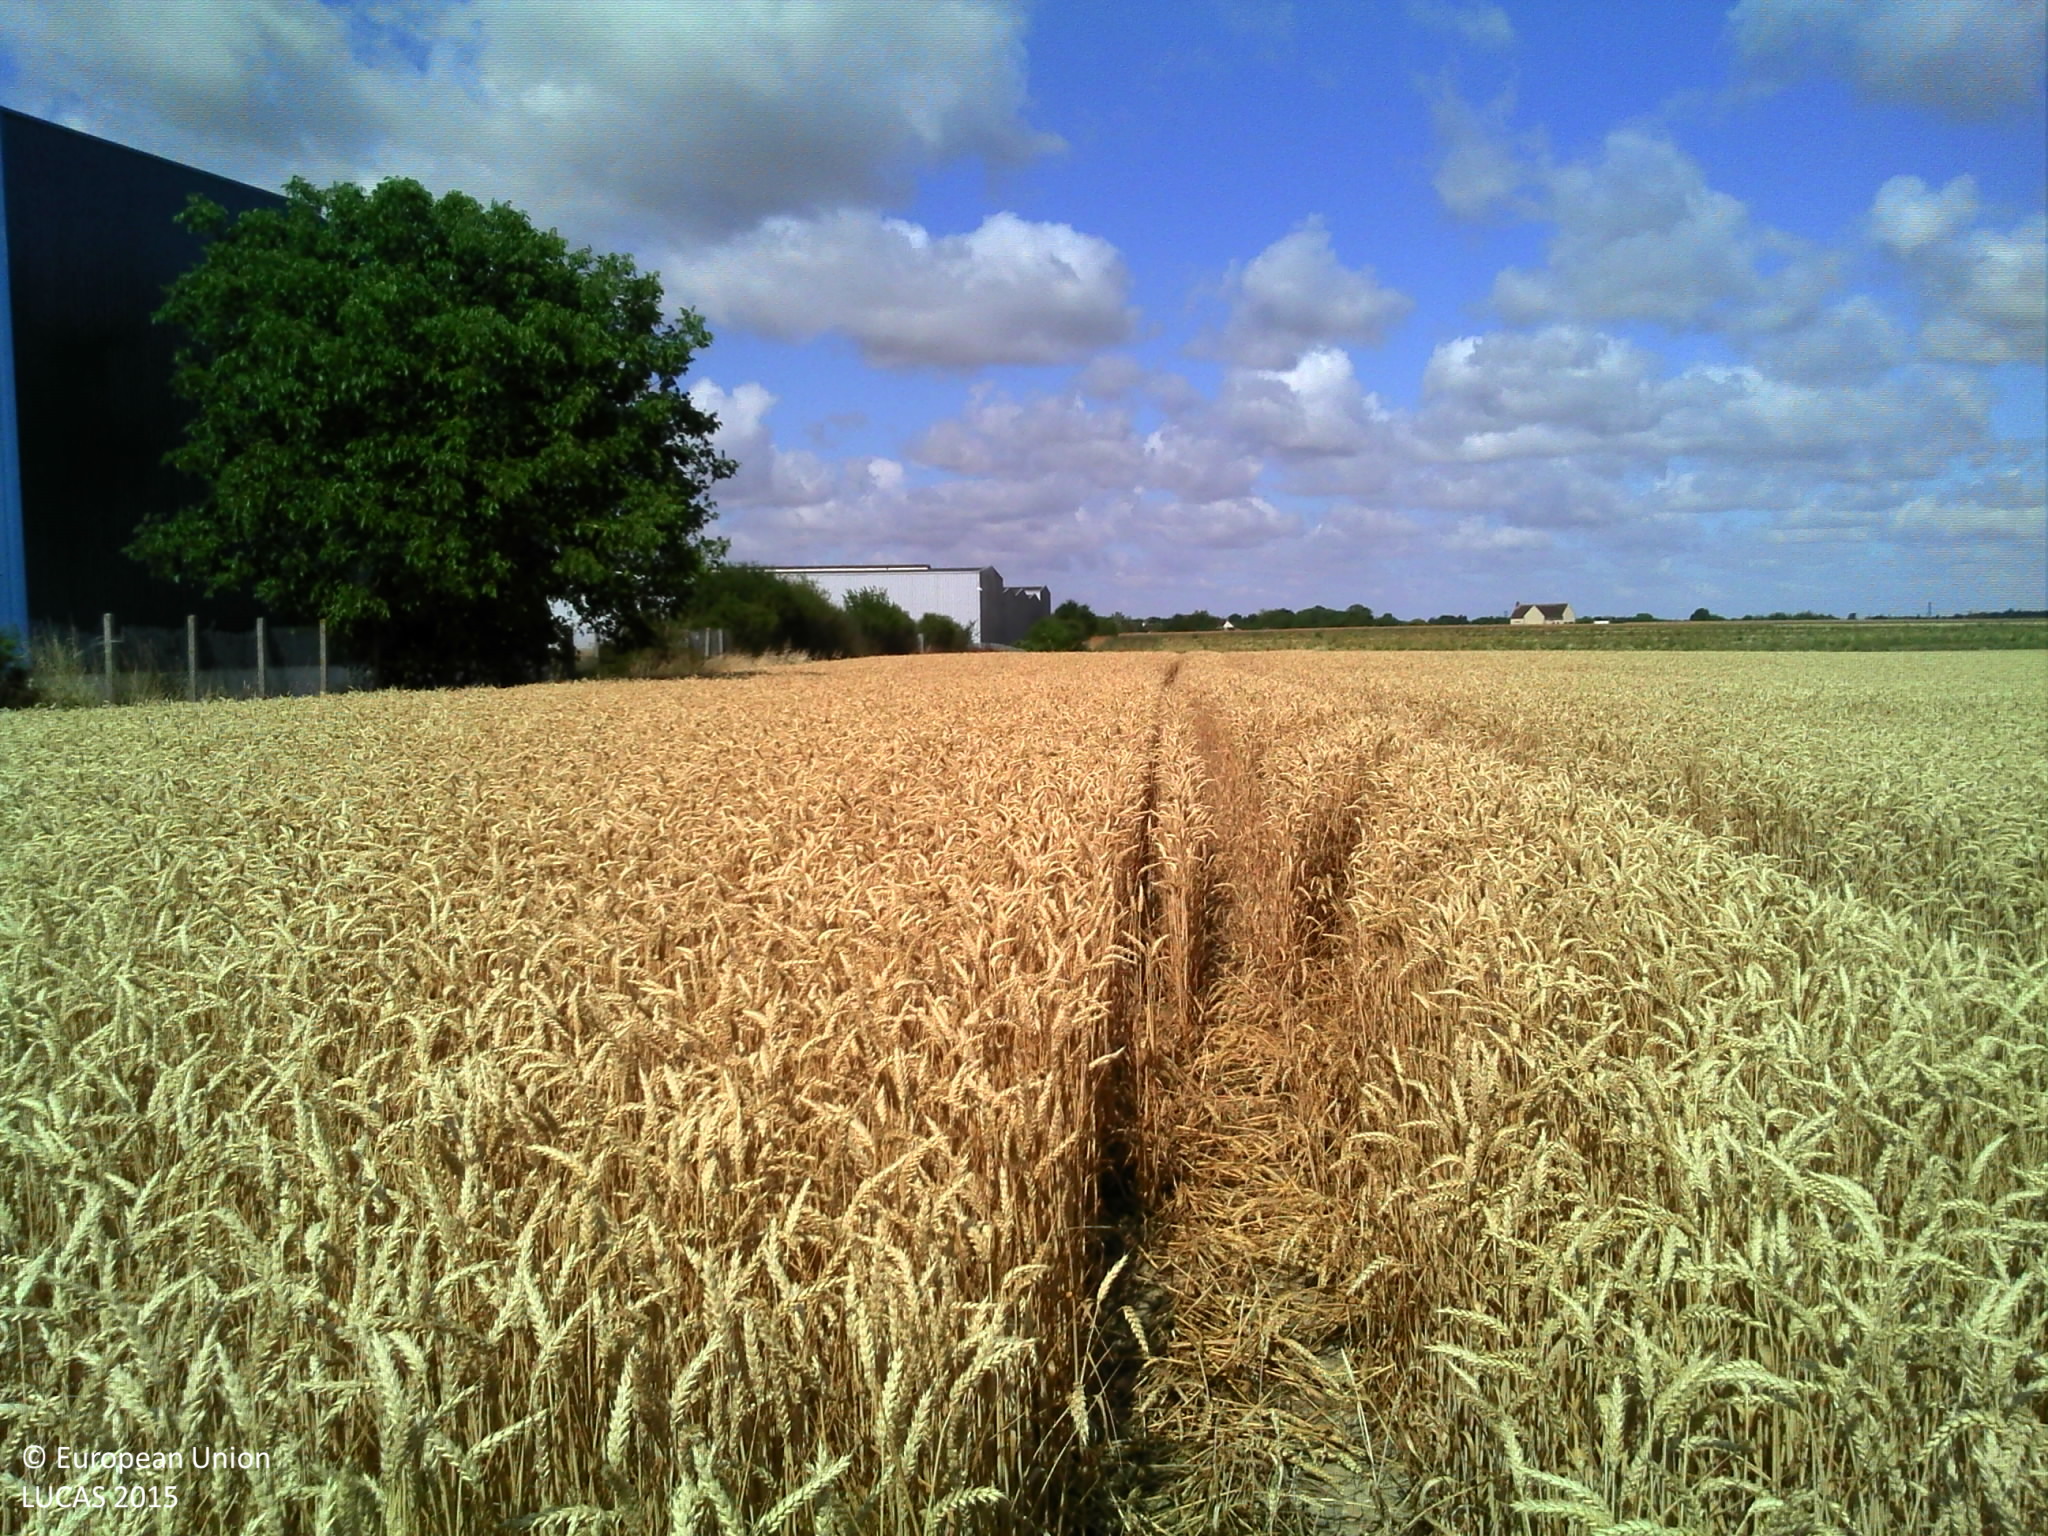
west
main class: Cropland
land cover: Common wheat
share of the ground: > 75 %
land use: Agriculture (excluding fallow land and kitchen gardens)
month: July
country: FR
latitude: 48.0969
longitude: 2.8080
